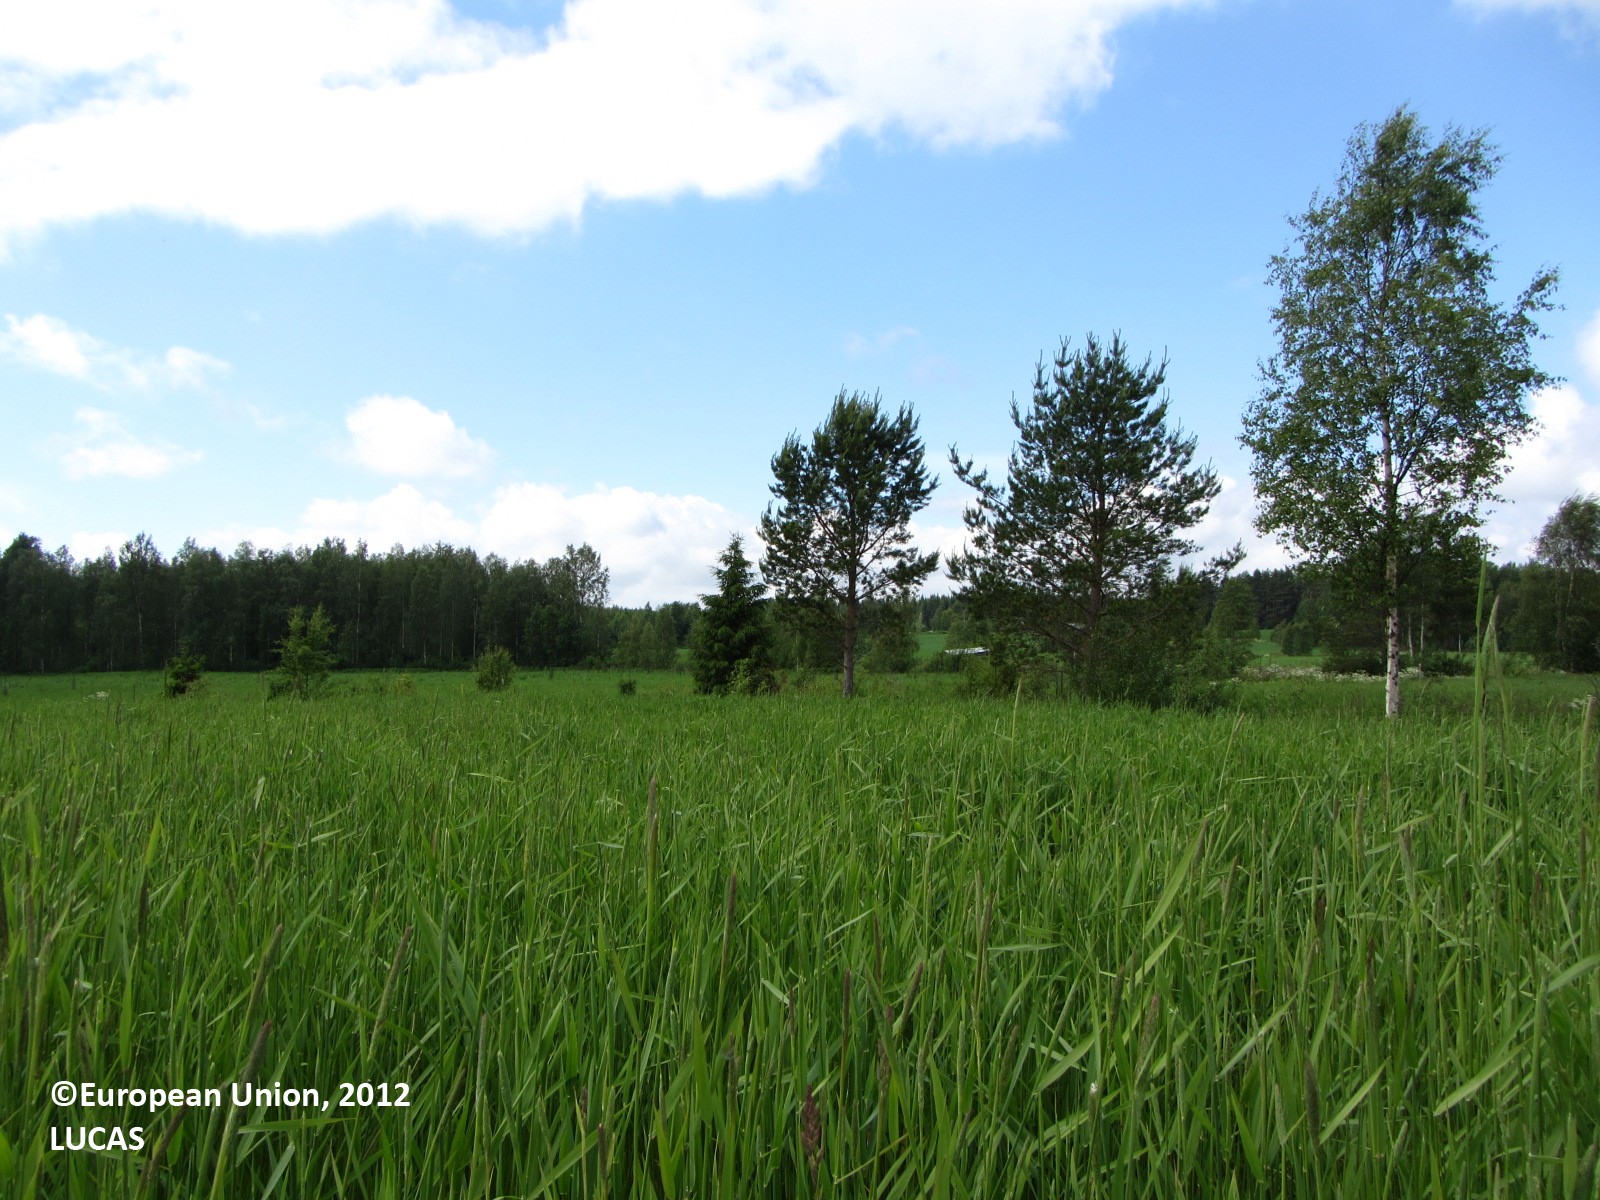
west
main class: Cropland
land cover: Temporary grasslands
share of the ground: > 75 %
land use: Agriculture (excluding fallow land and kitchen gardens)
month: July
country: FI
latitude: 62.8978
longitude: 25.0706
